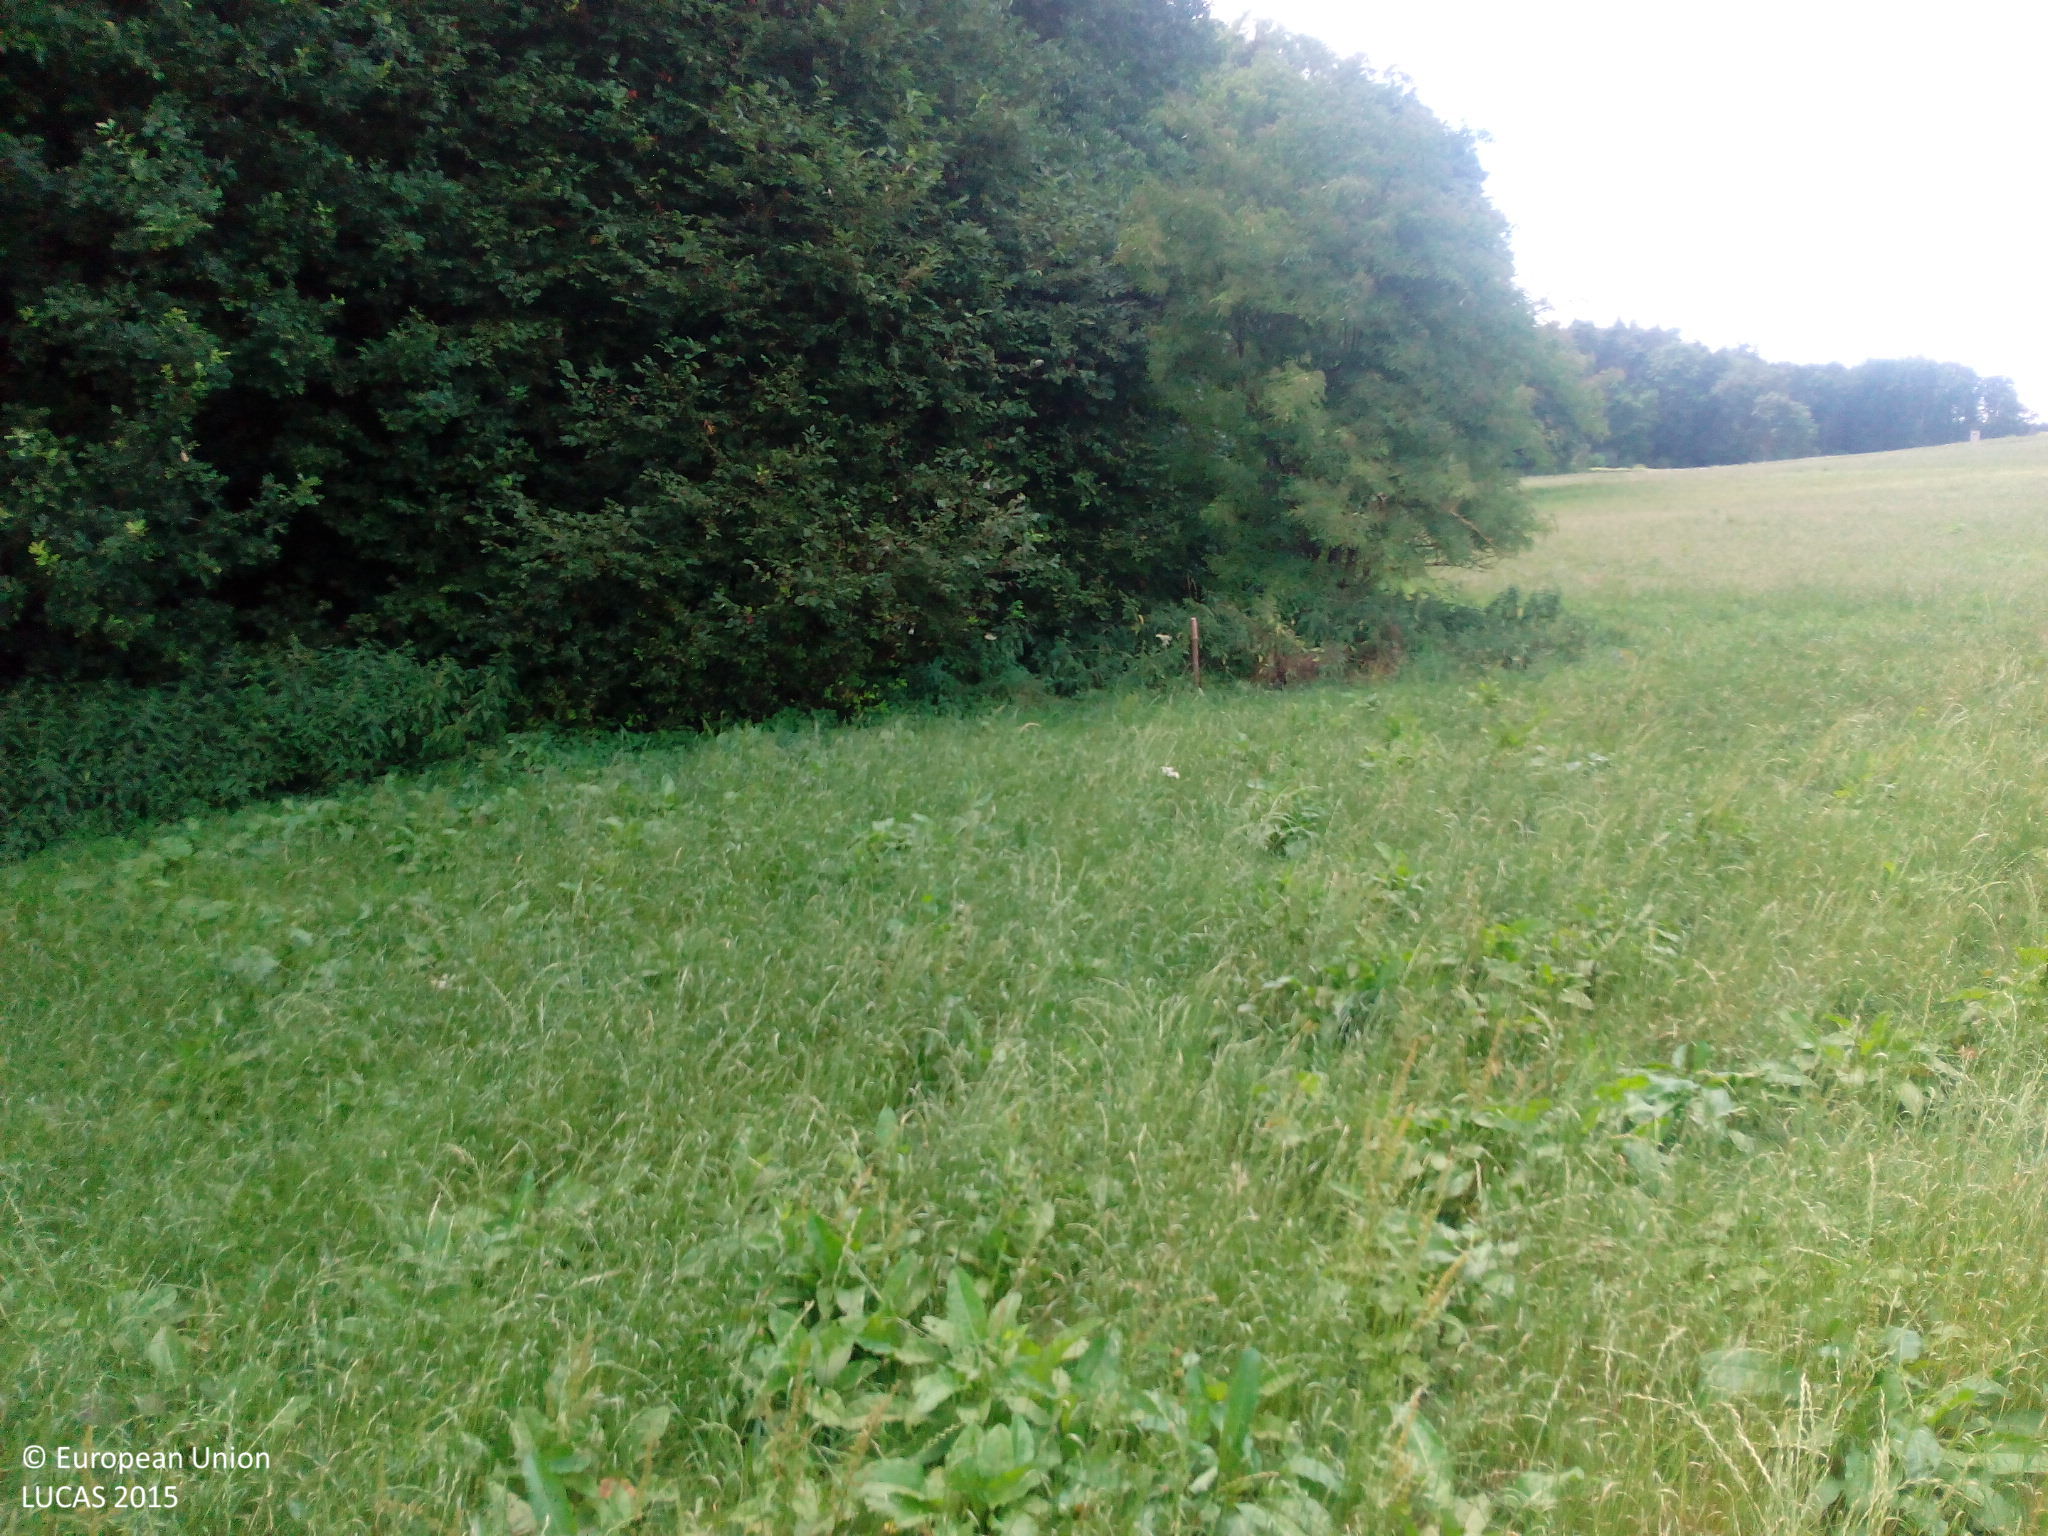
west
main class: Grassland
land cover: Grassland without tree/shrub cover
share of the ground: > 75 %
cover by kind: herbaceous plants 100 %
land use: Agriculture (excluding fallow land and kitchen gardens)
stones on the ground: < 10 %
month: July
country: DE
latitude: 49.4433
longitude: 10.8962
